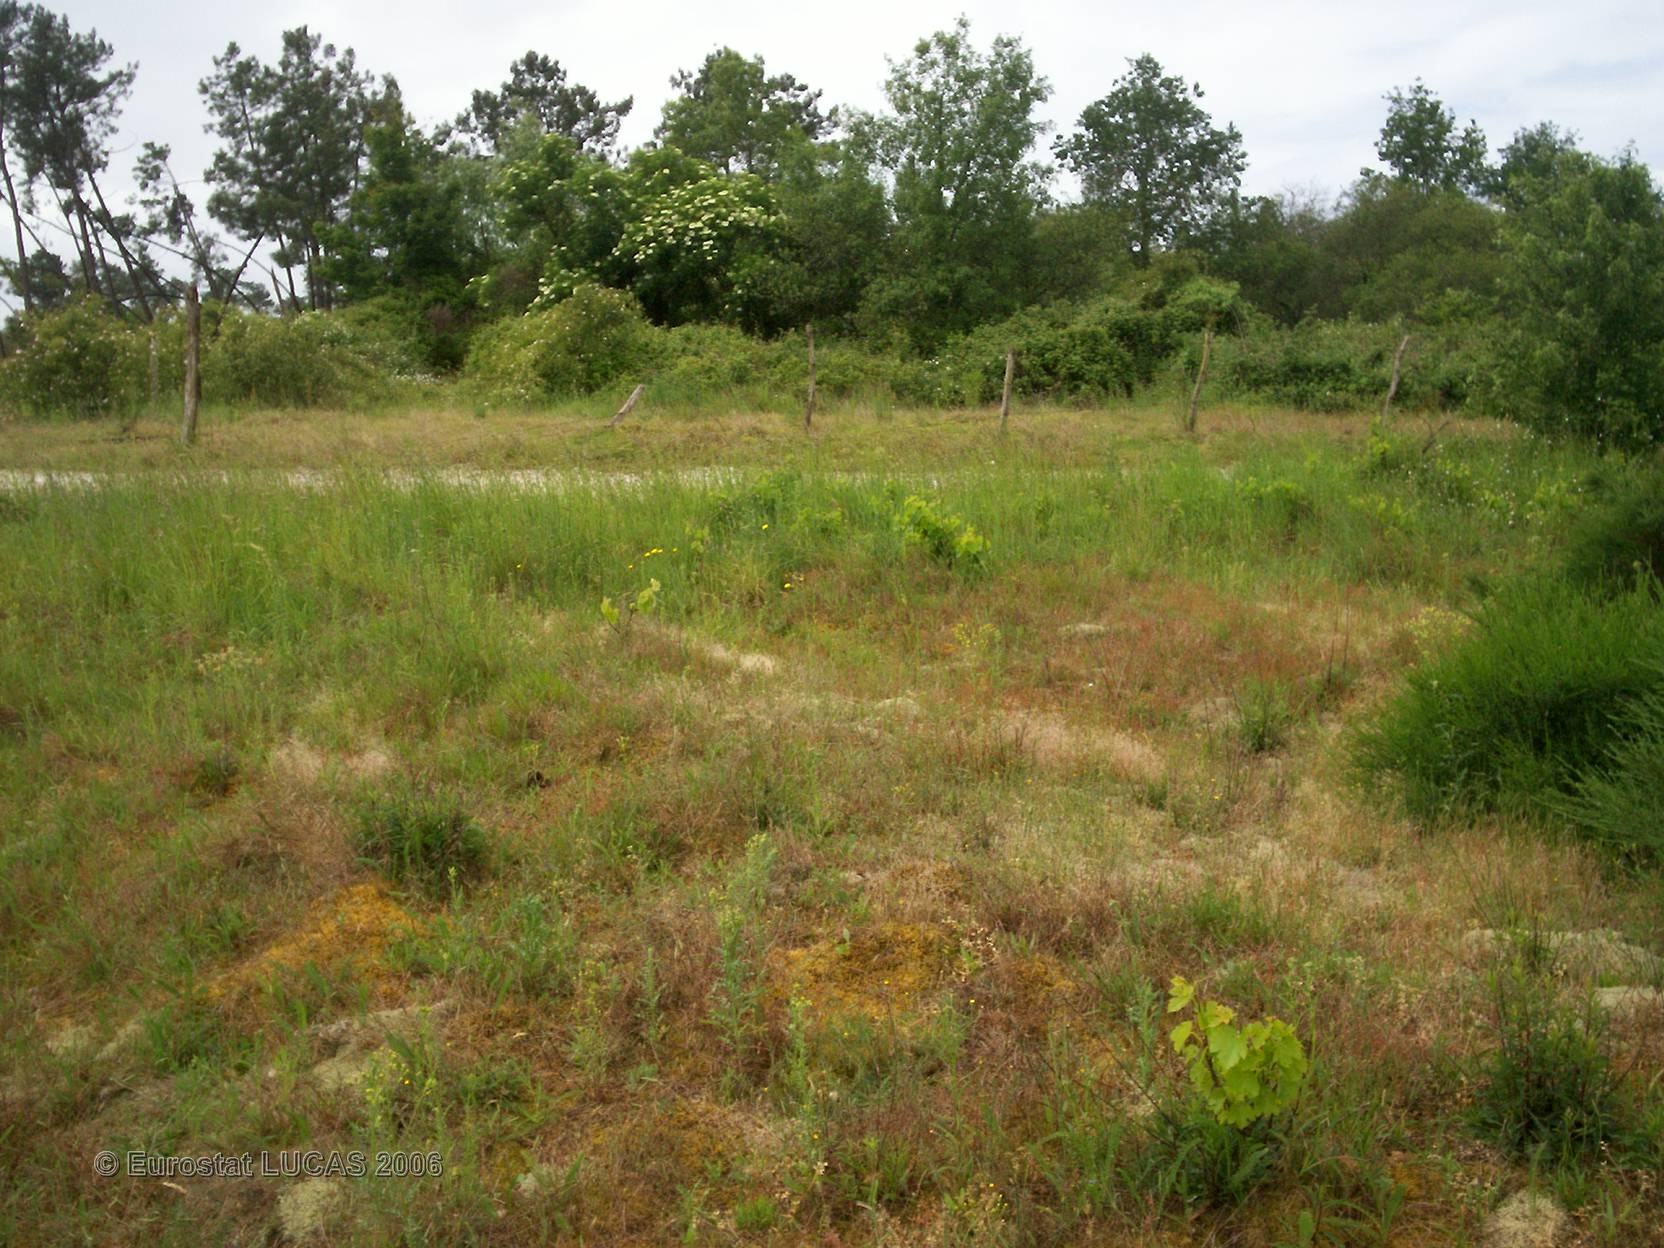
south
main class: Grassland
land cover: Grassland with sparse tree/shrub cover
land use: Unused
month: May
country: FR
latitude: 45.4156
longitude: -1.0288
